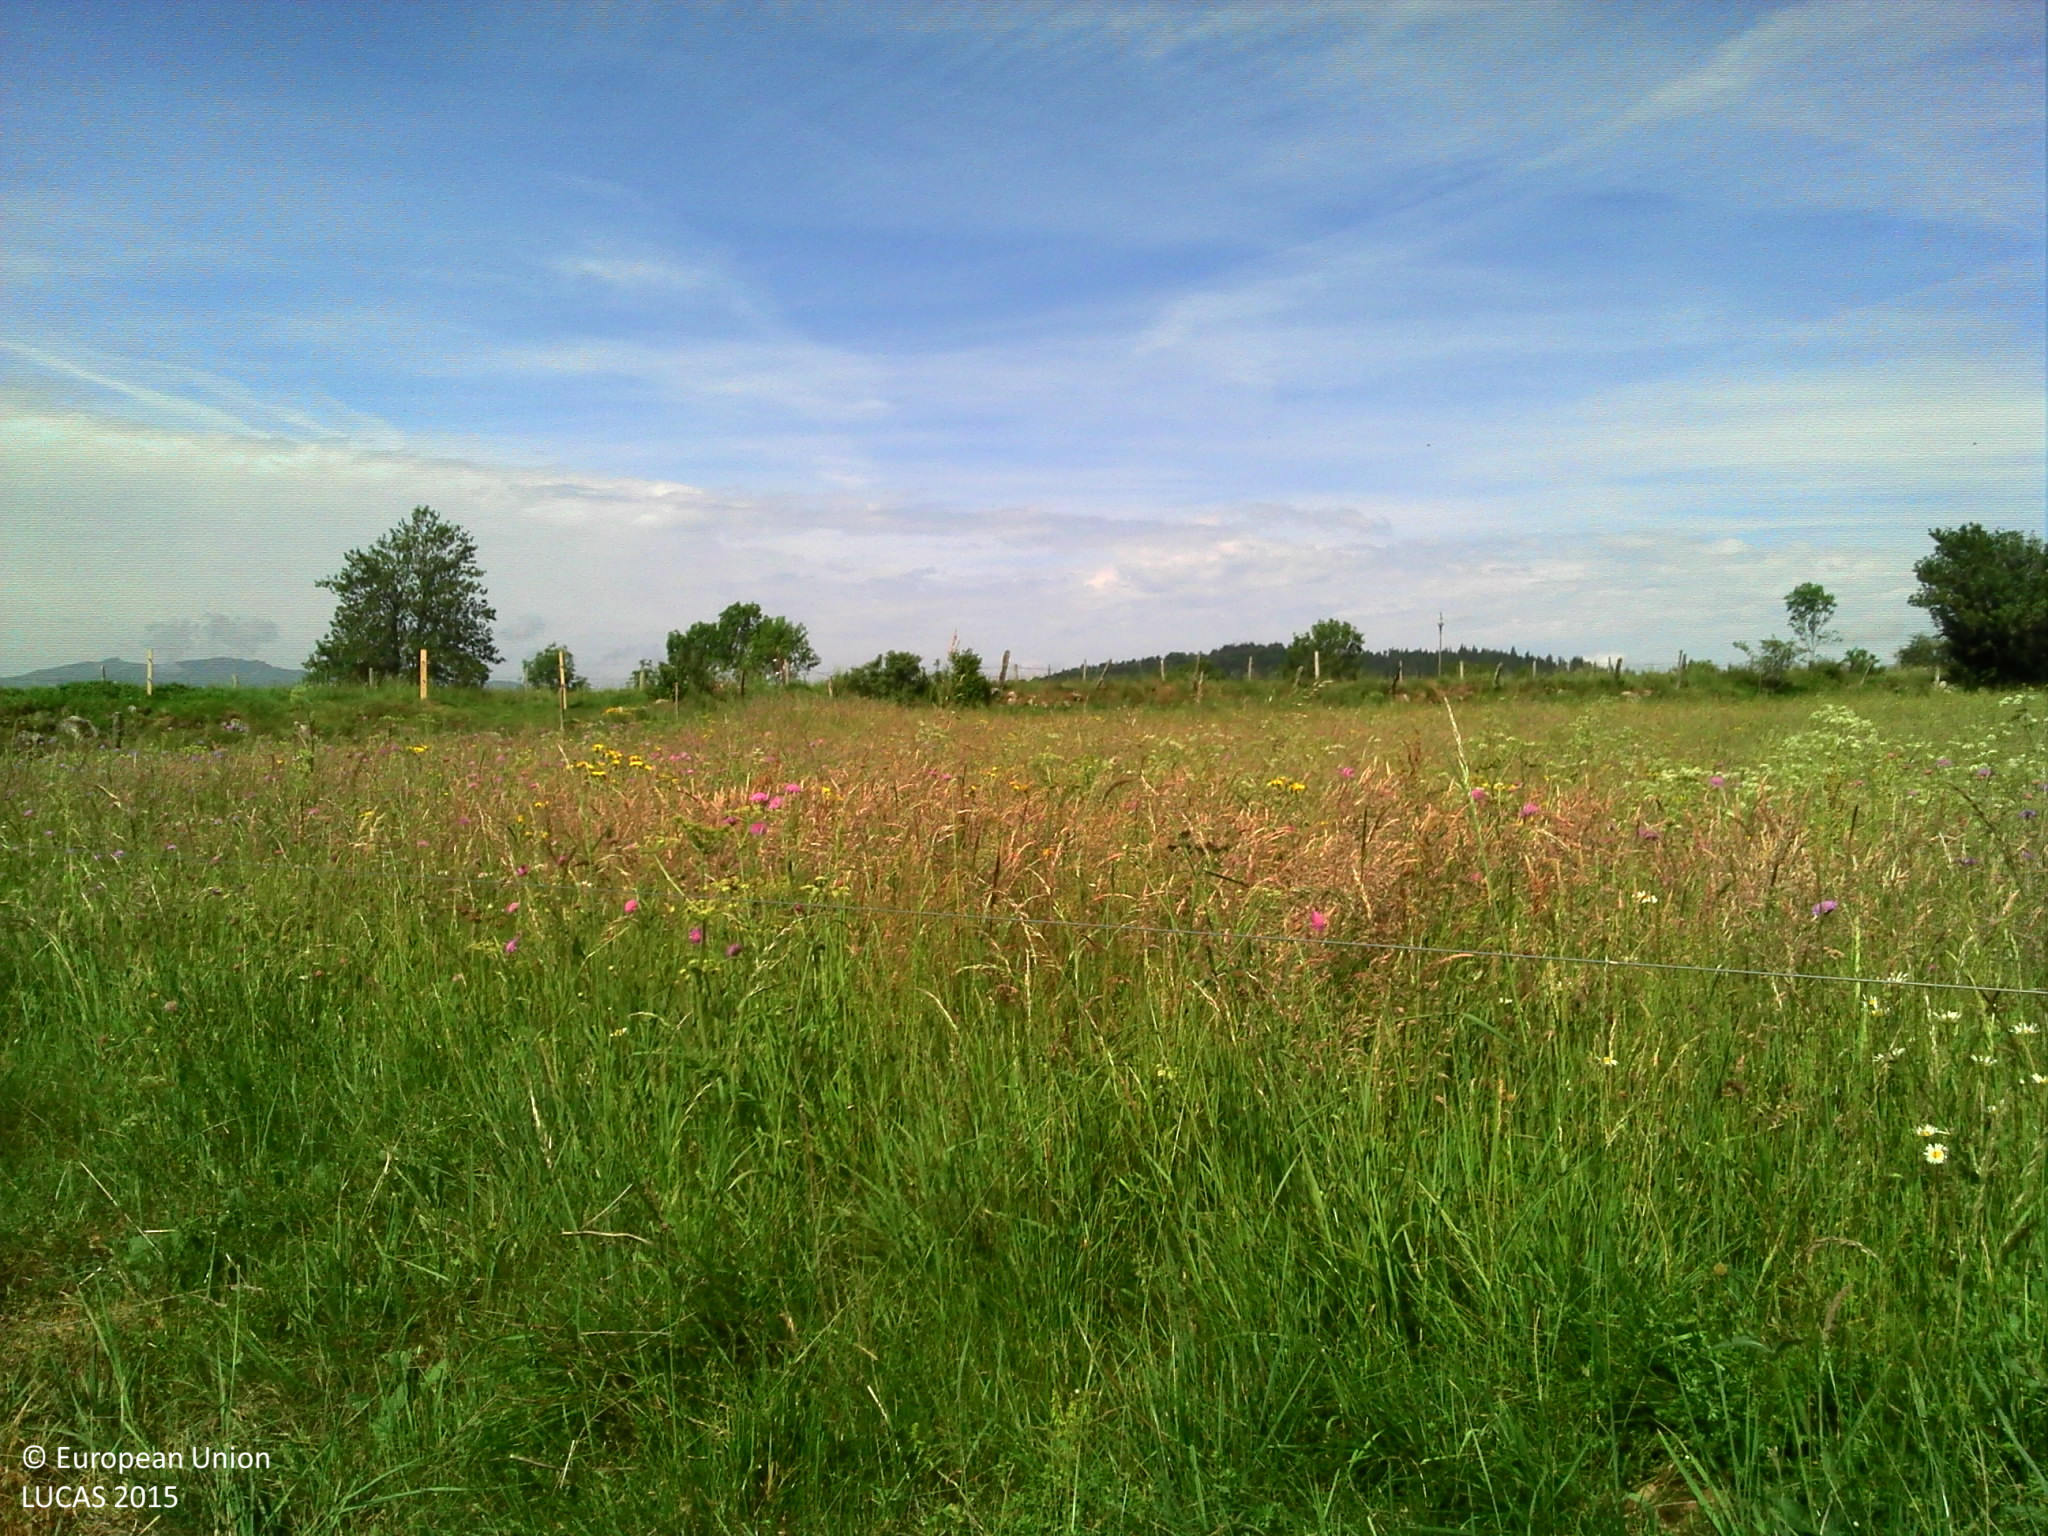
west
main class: Grassland
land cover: Grassland without tree/shrub cover
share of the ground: > 75 %
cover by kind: herbaceous plants 100 %
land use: Agriculture (excluding fallow land and kitchen gardens)
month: June
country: FR
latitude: 45.1398
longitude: 2.9181
